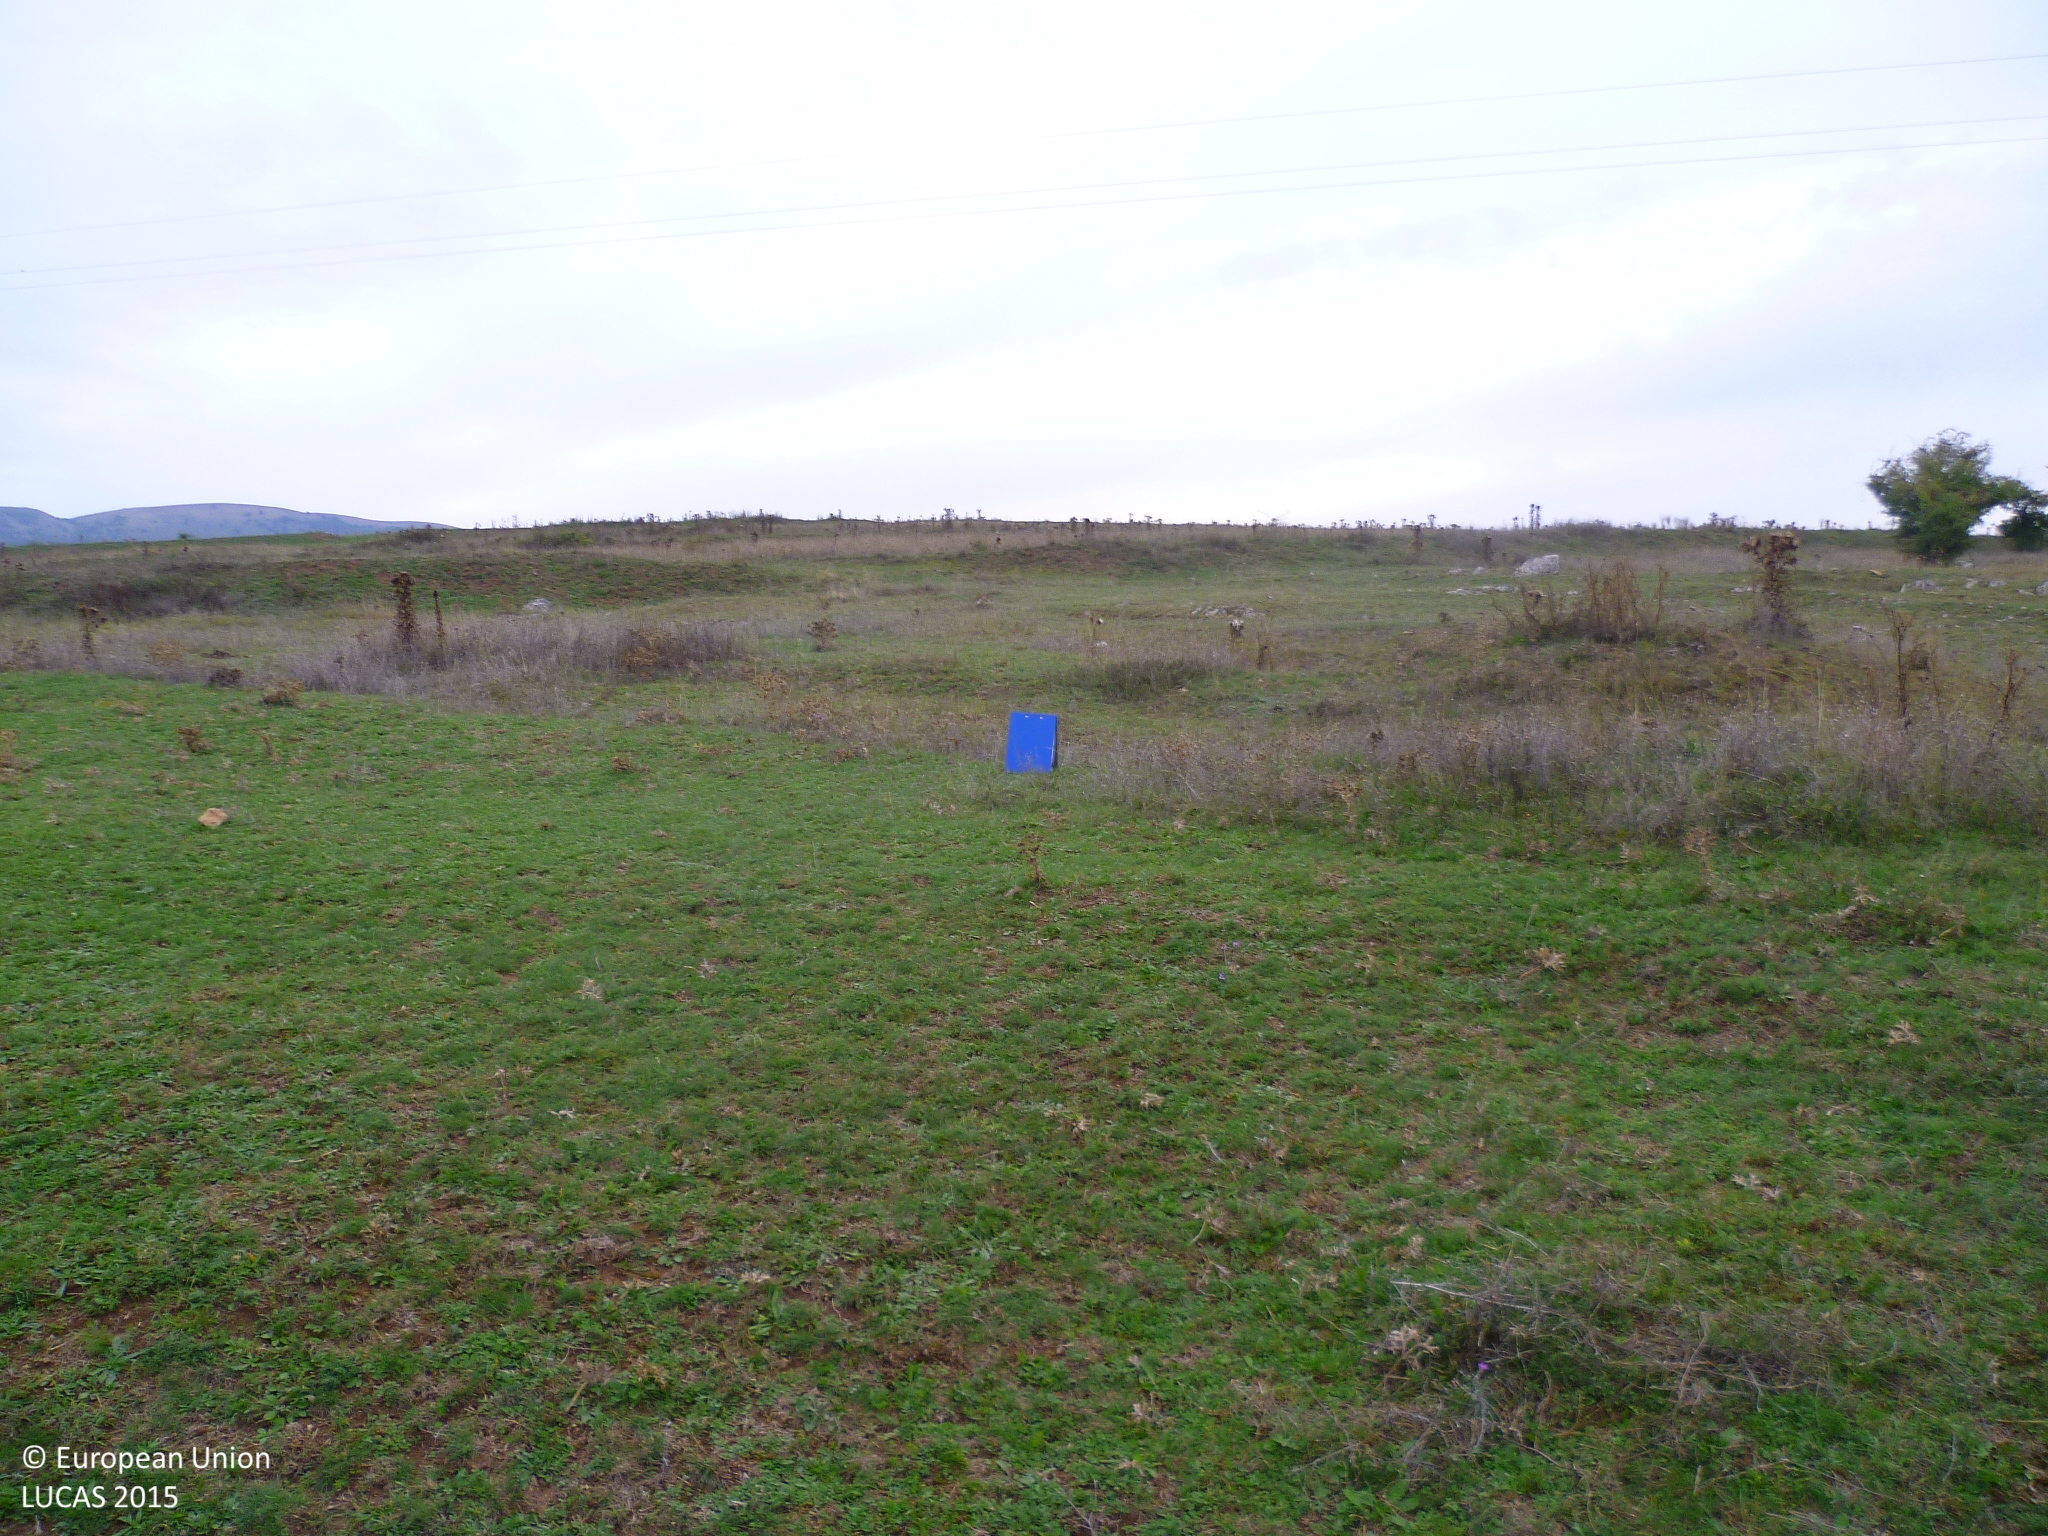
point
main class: Grassland
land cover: Grassland without tree/shrub cover
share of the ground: > 75 %
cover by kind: herbaceous plants 100 %
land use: Agriculture (excluding fallow land and kitchen gardens)
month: October
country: BG
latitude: 43.0143
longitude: 23.0266
